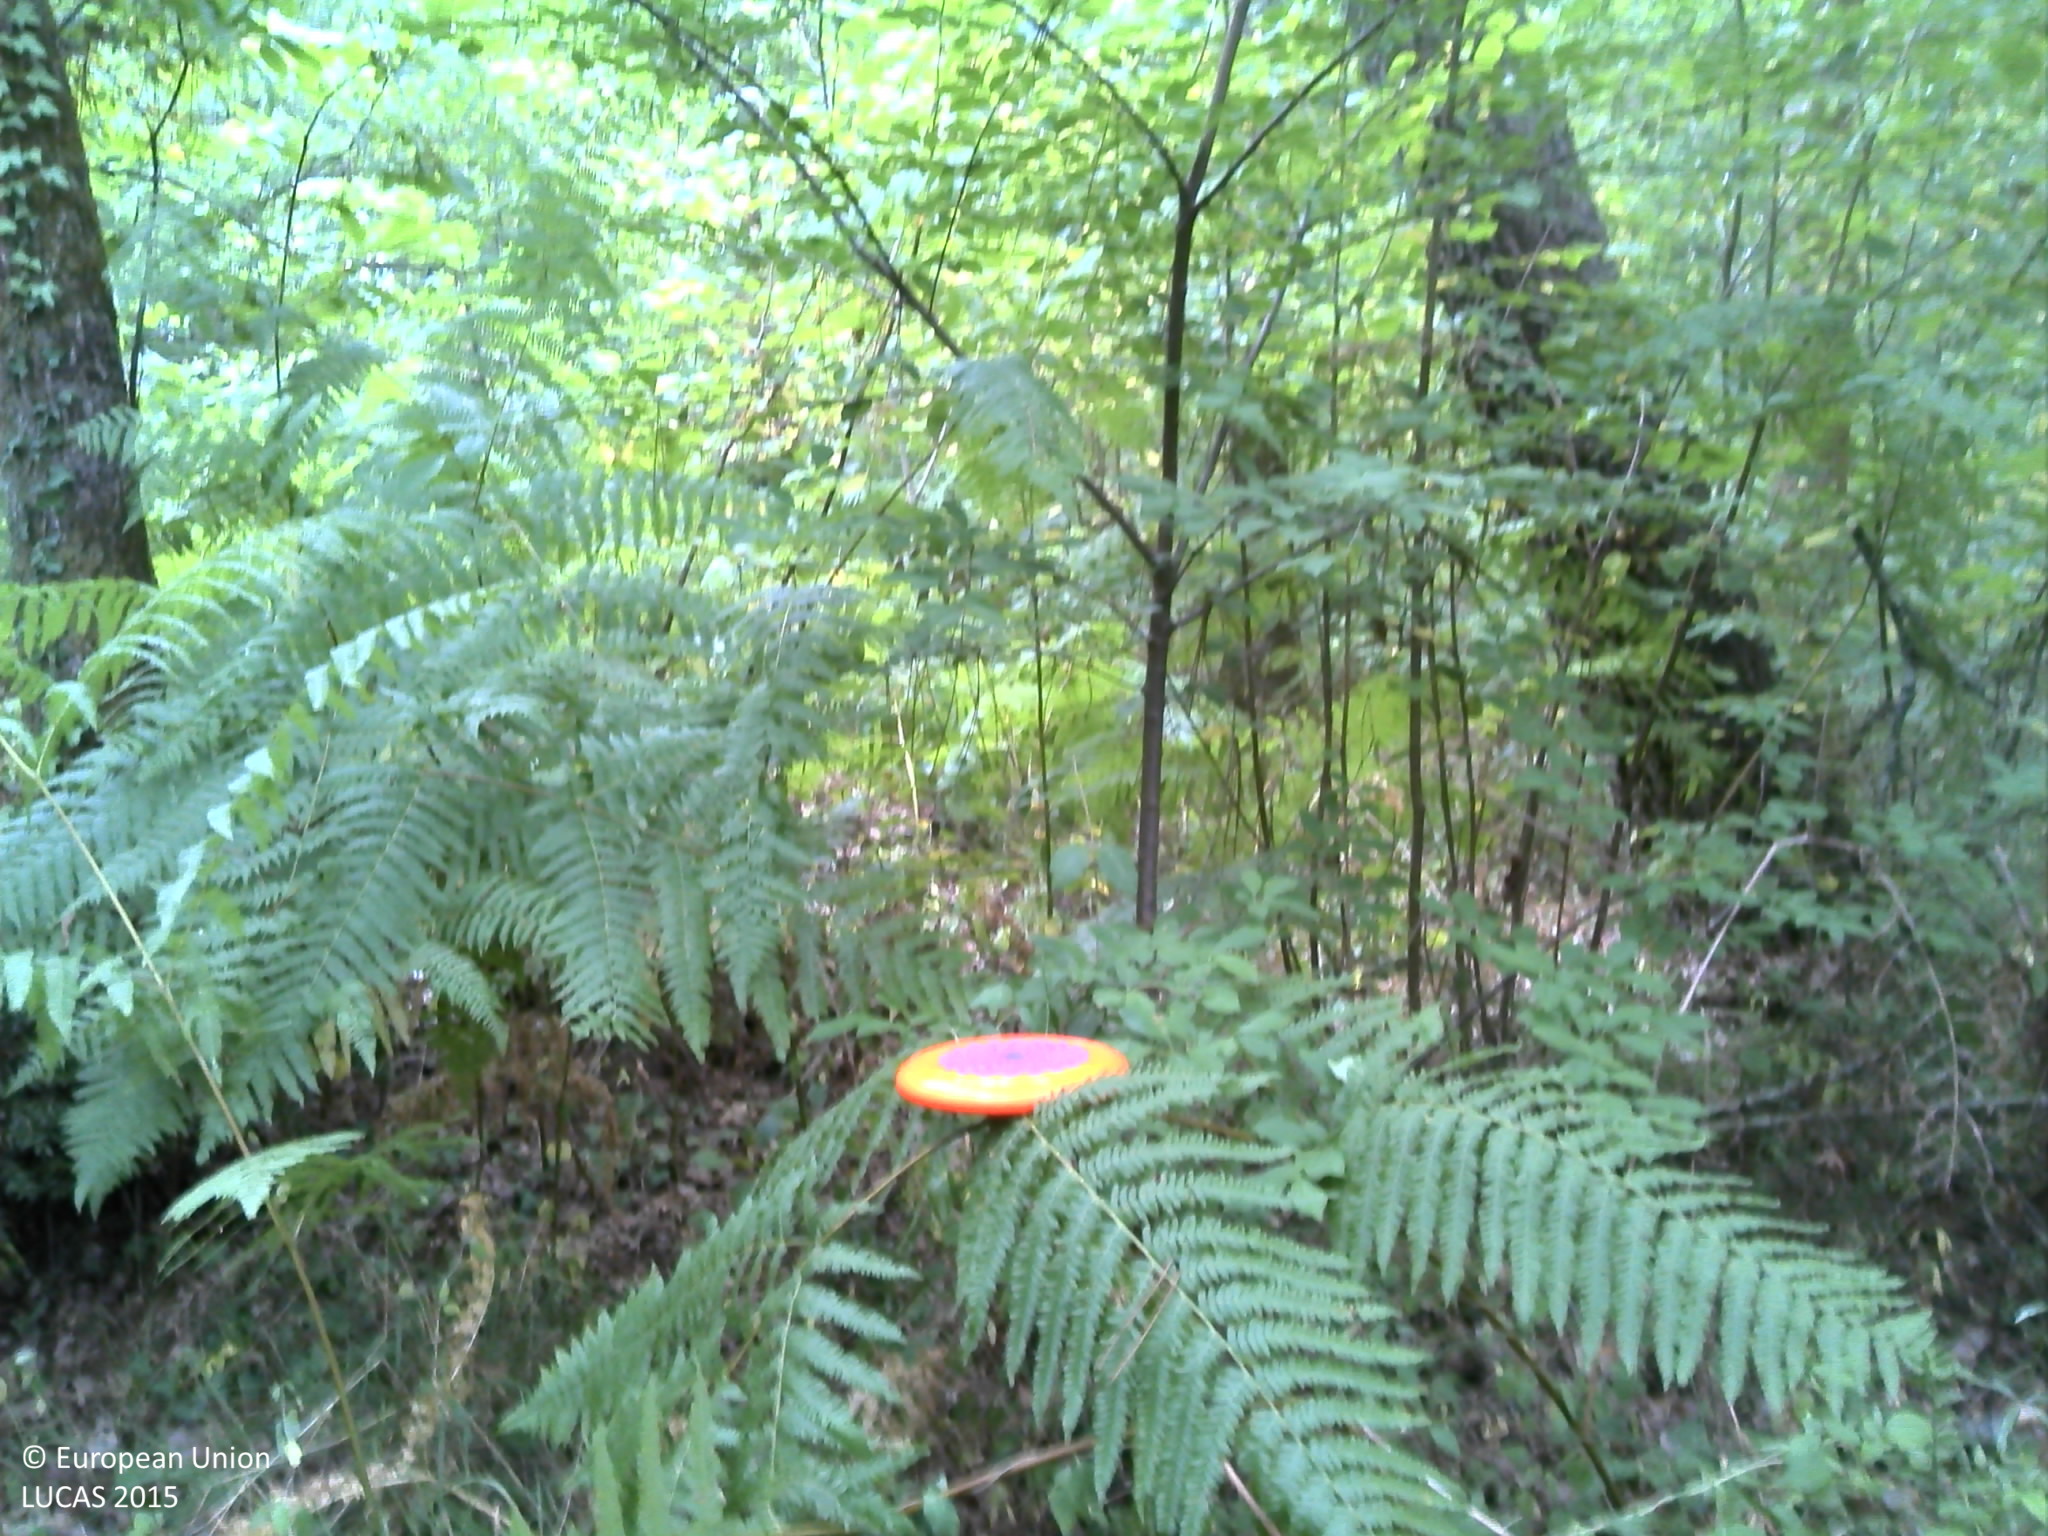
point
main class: Woodland
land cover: Broadleaved woodland
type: floodplain forest
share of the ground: > 75 %
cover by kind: broadleaved forest trees 70 %, shrubs 20 %, herbaceous plants 5 %, lichens and mosses 5 %
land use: Forestry
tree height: > 5 m
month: July
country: FR
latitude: 44.6630
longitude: -0.5738
